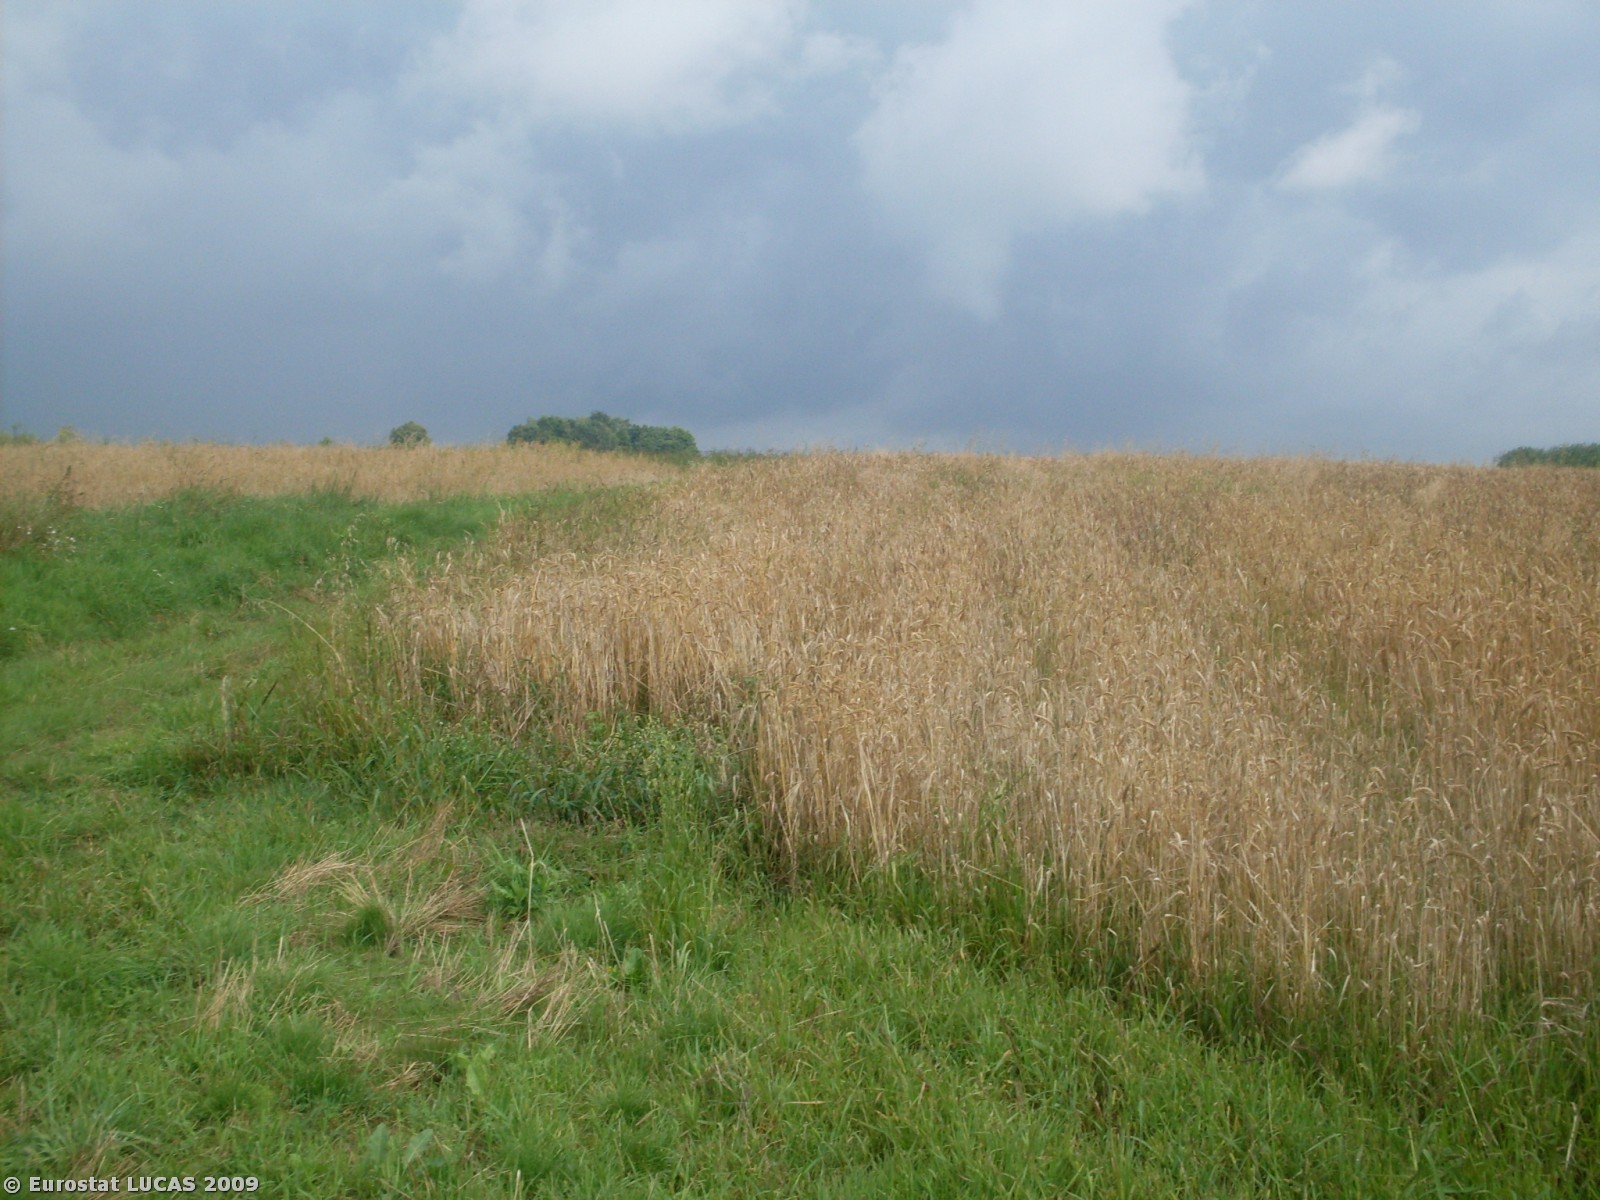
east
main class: Grassland
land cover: Grassland without tree/shrub cover
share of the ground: > 75 %
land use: Agriculture (excluding fallow land and kitchen gardens)
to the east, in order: Grassland without tree/shrub cover; Mixed cereals for fodder; Tracks; Mixed cereals for fodder; Potatoes; Tracks; Rye; Tracks; Mixed cereals for fodder
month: August
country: PL
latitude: 49.9821
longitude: 21.1323
